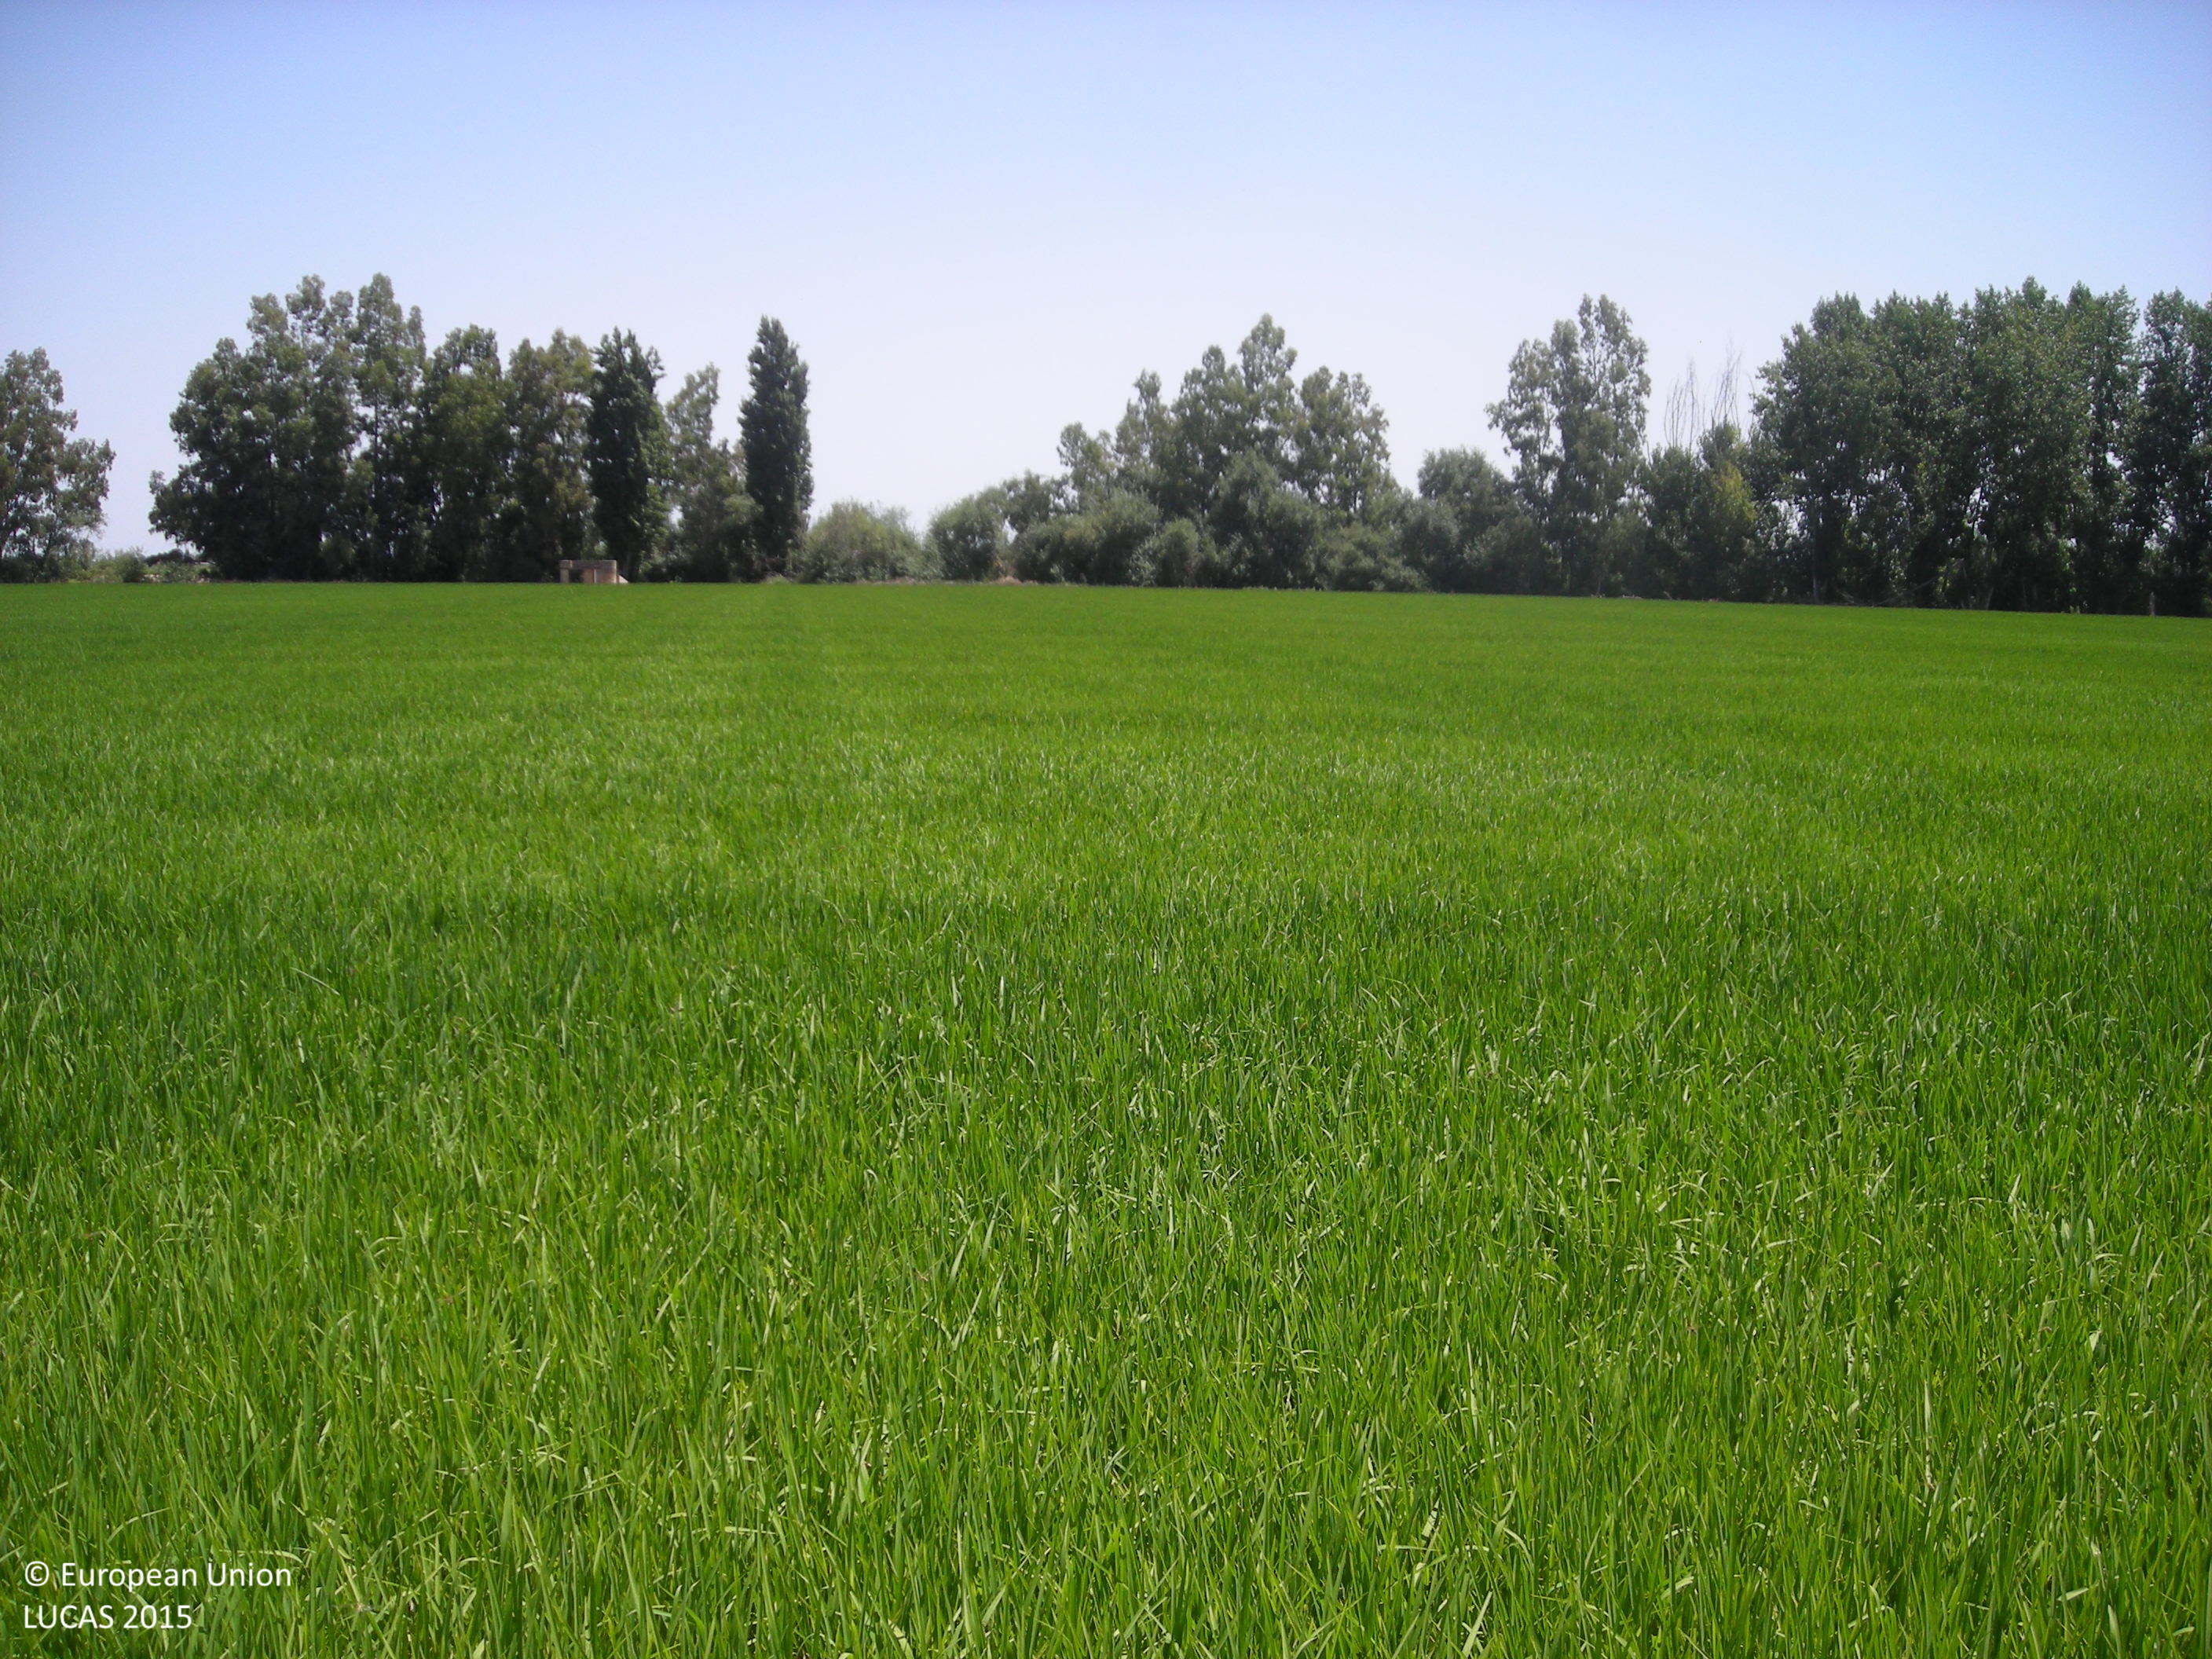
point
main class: Cropland
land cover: Rice
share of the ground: > 75 %
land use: Agriculture (excluding fallow land and kitchen gardens)
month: July
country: ES
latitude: 39.1047
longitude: -5.8124
